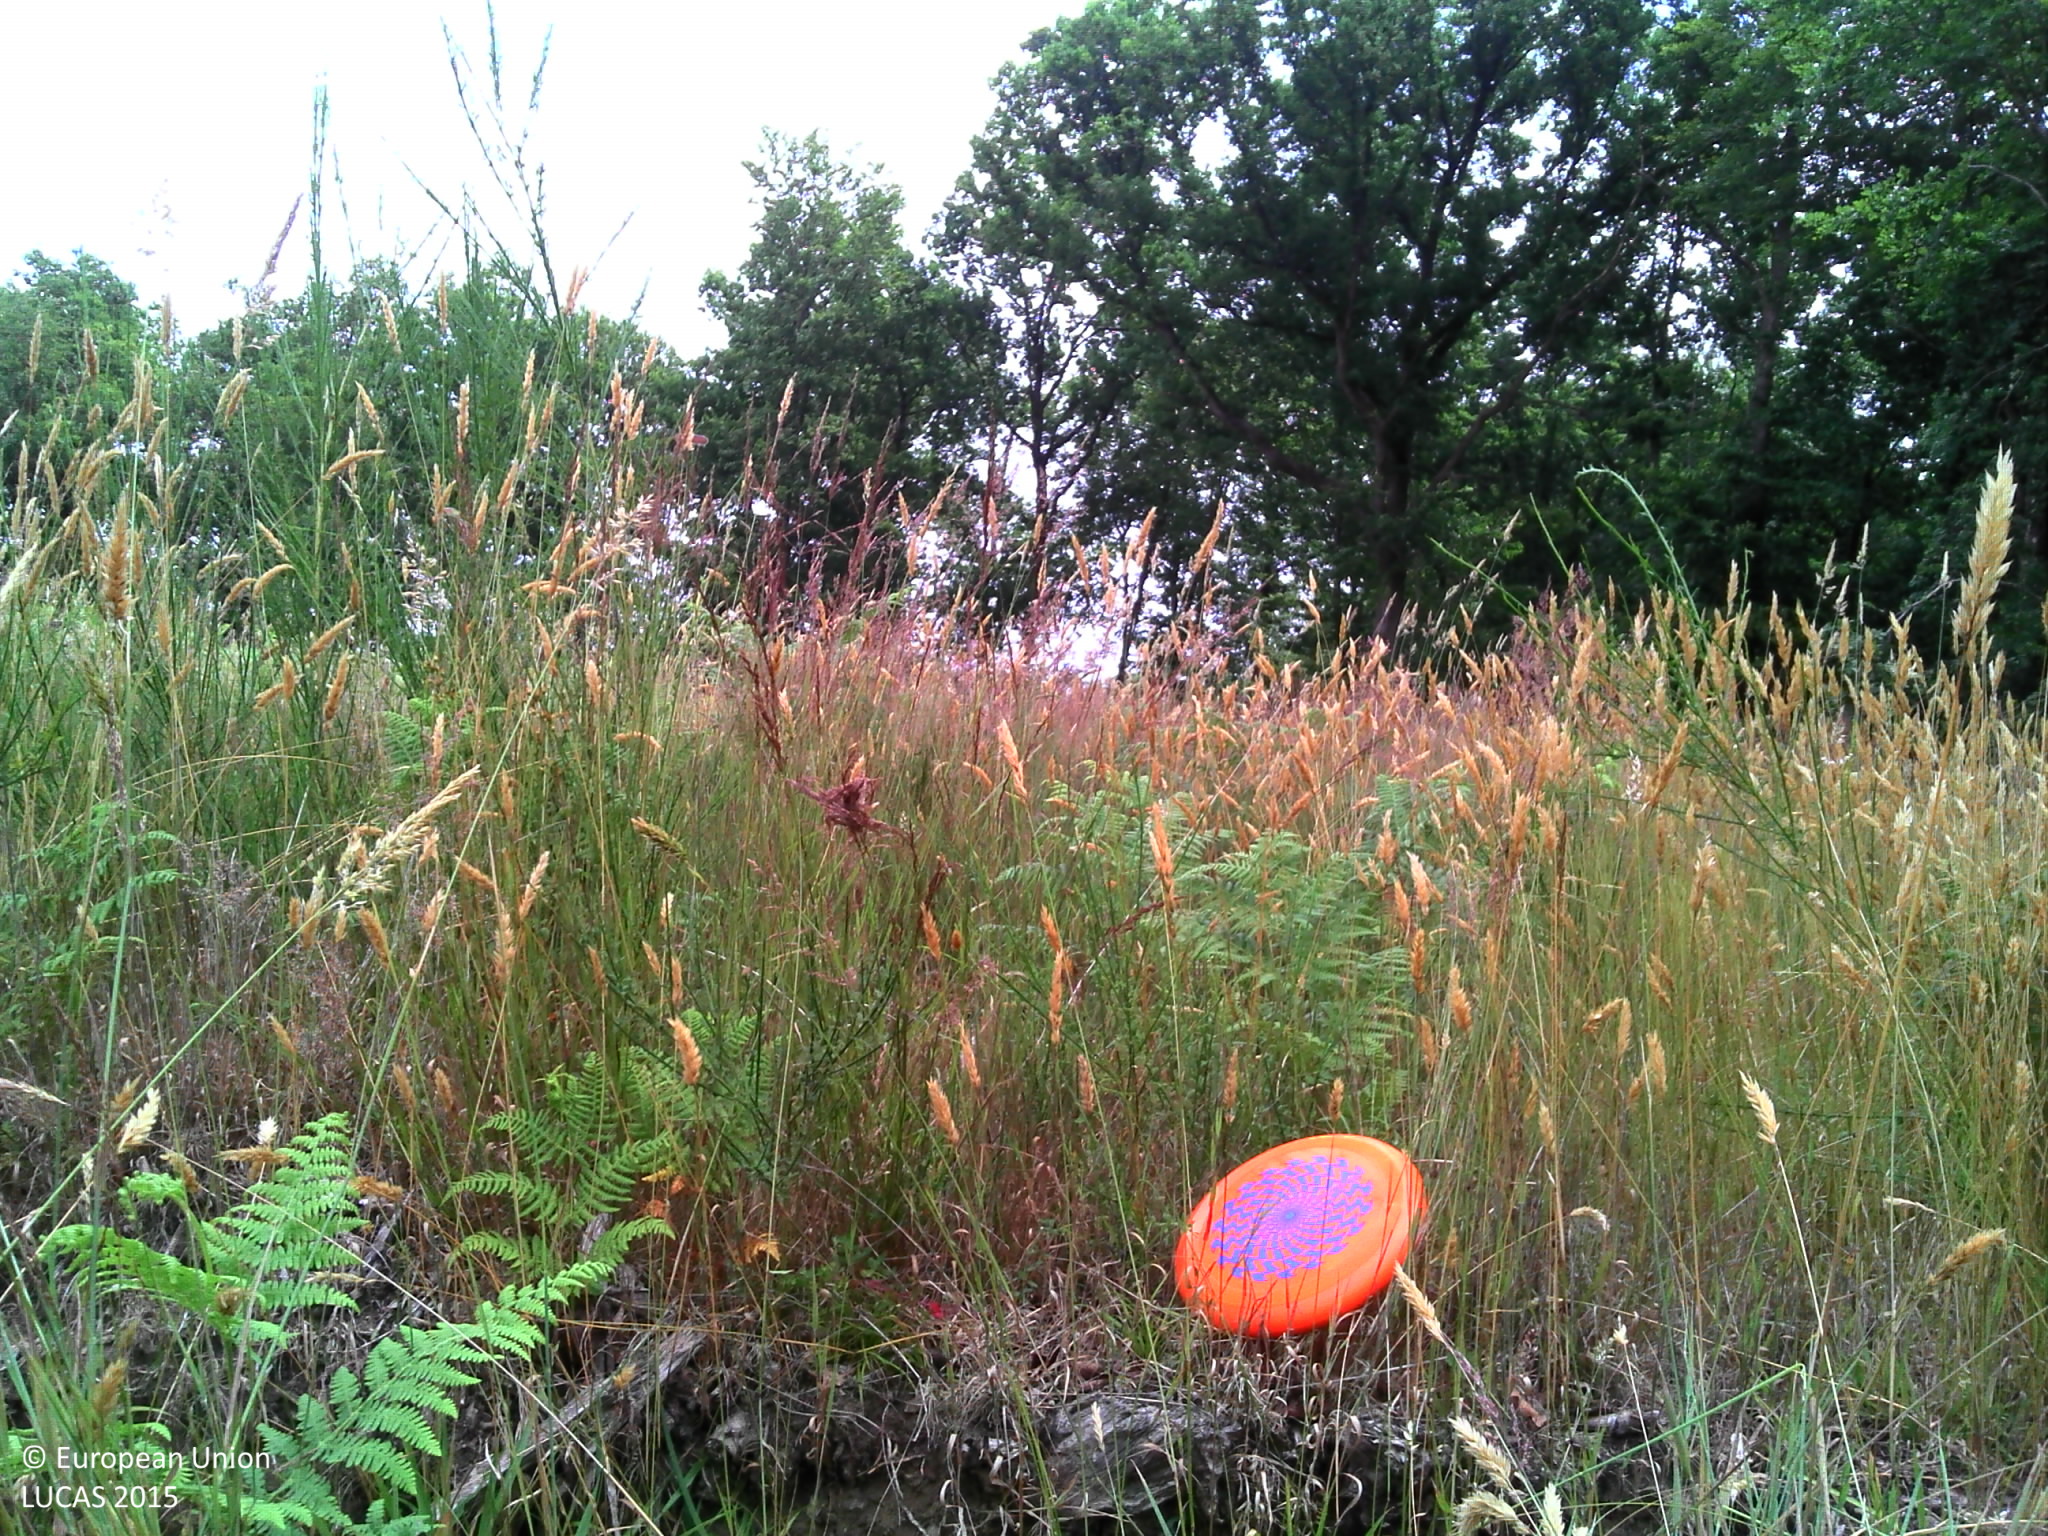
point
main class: Grassland
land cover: Spontaneously vegetated surfaces
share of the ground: > 75 %
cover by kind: herbaceous plants 75 %, unconsolidated bare surface 20 %, shrubs 5 %
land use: Forestry
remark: Clear cut
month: July
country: FR
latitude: 48.4335
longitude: -2.3725
